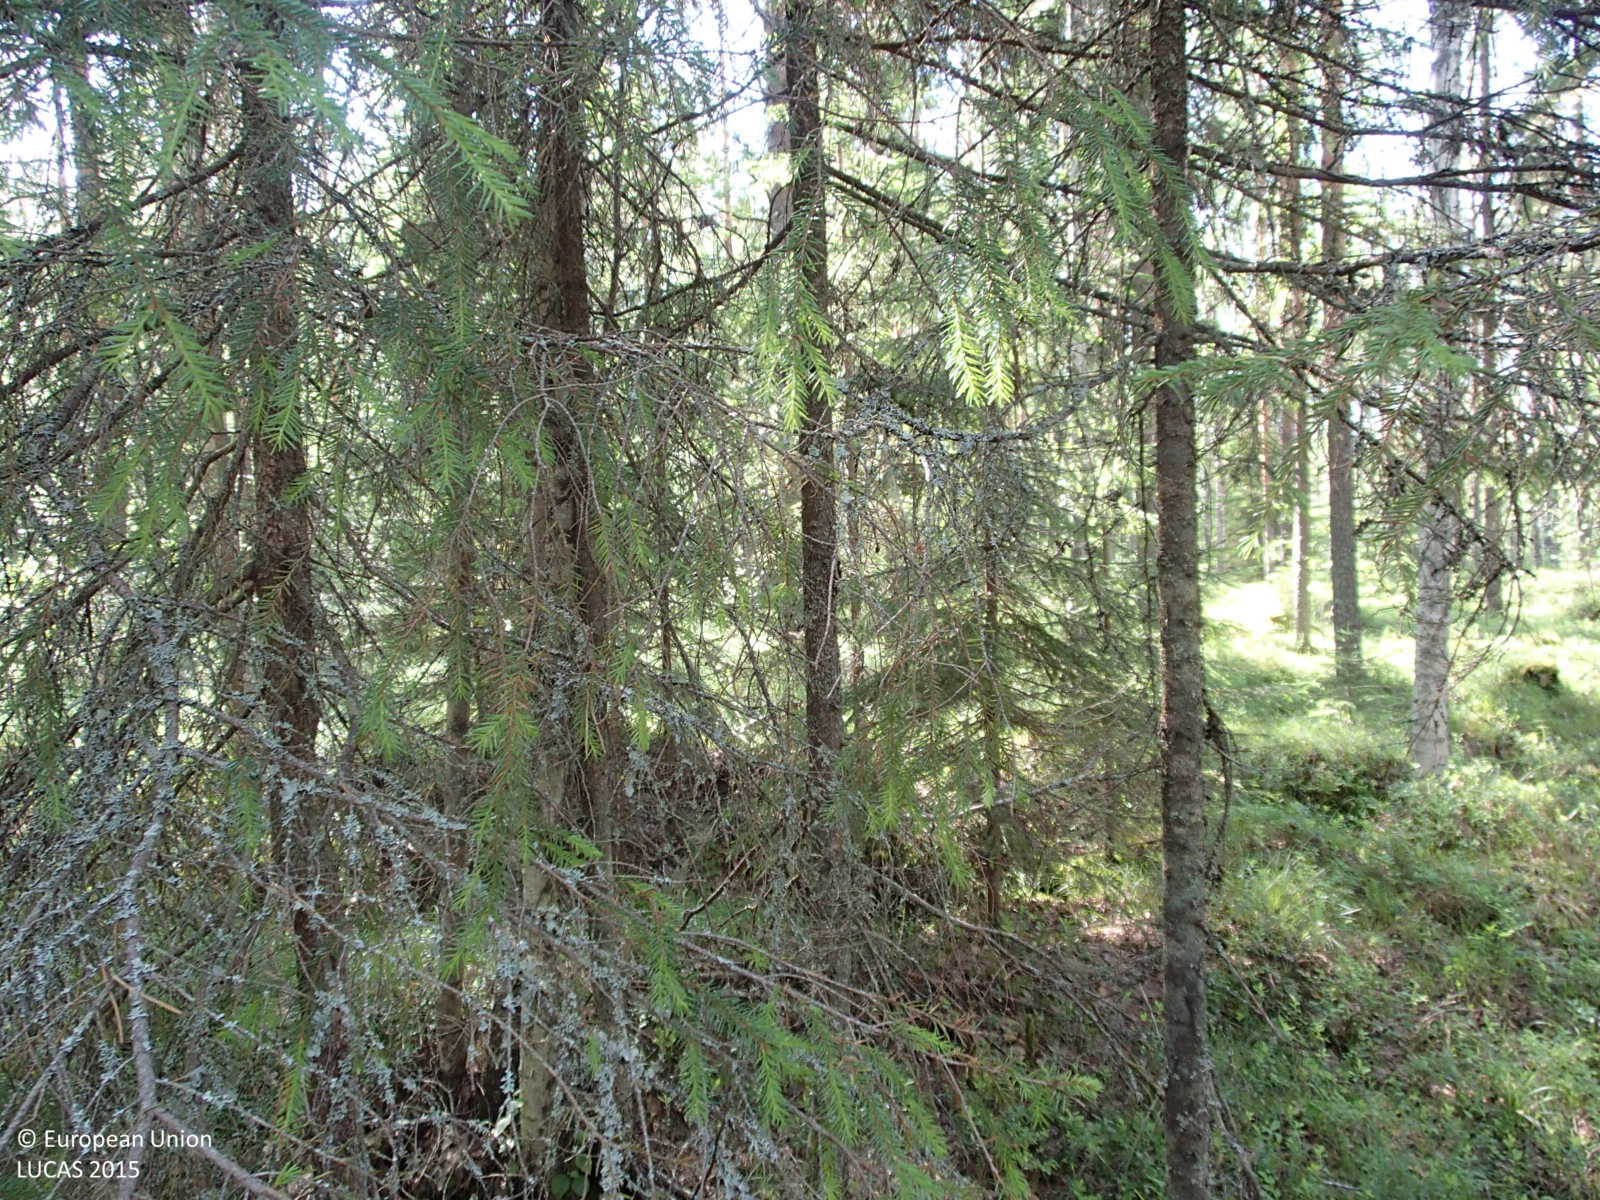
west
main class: Woodland
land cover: Other mixed woodland
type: boreal forest
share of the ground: > 75 %
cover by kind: coniferous forest trees 60 %, broadleaved forest trees 20 %, shrubs 20 %
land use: Forestry
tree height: > 5 m
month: July
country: FI
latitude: 64.1166
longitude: 27.2007
